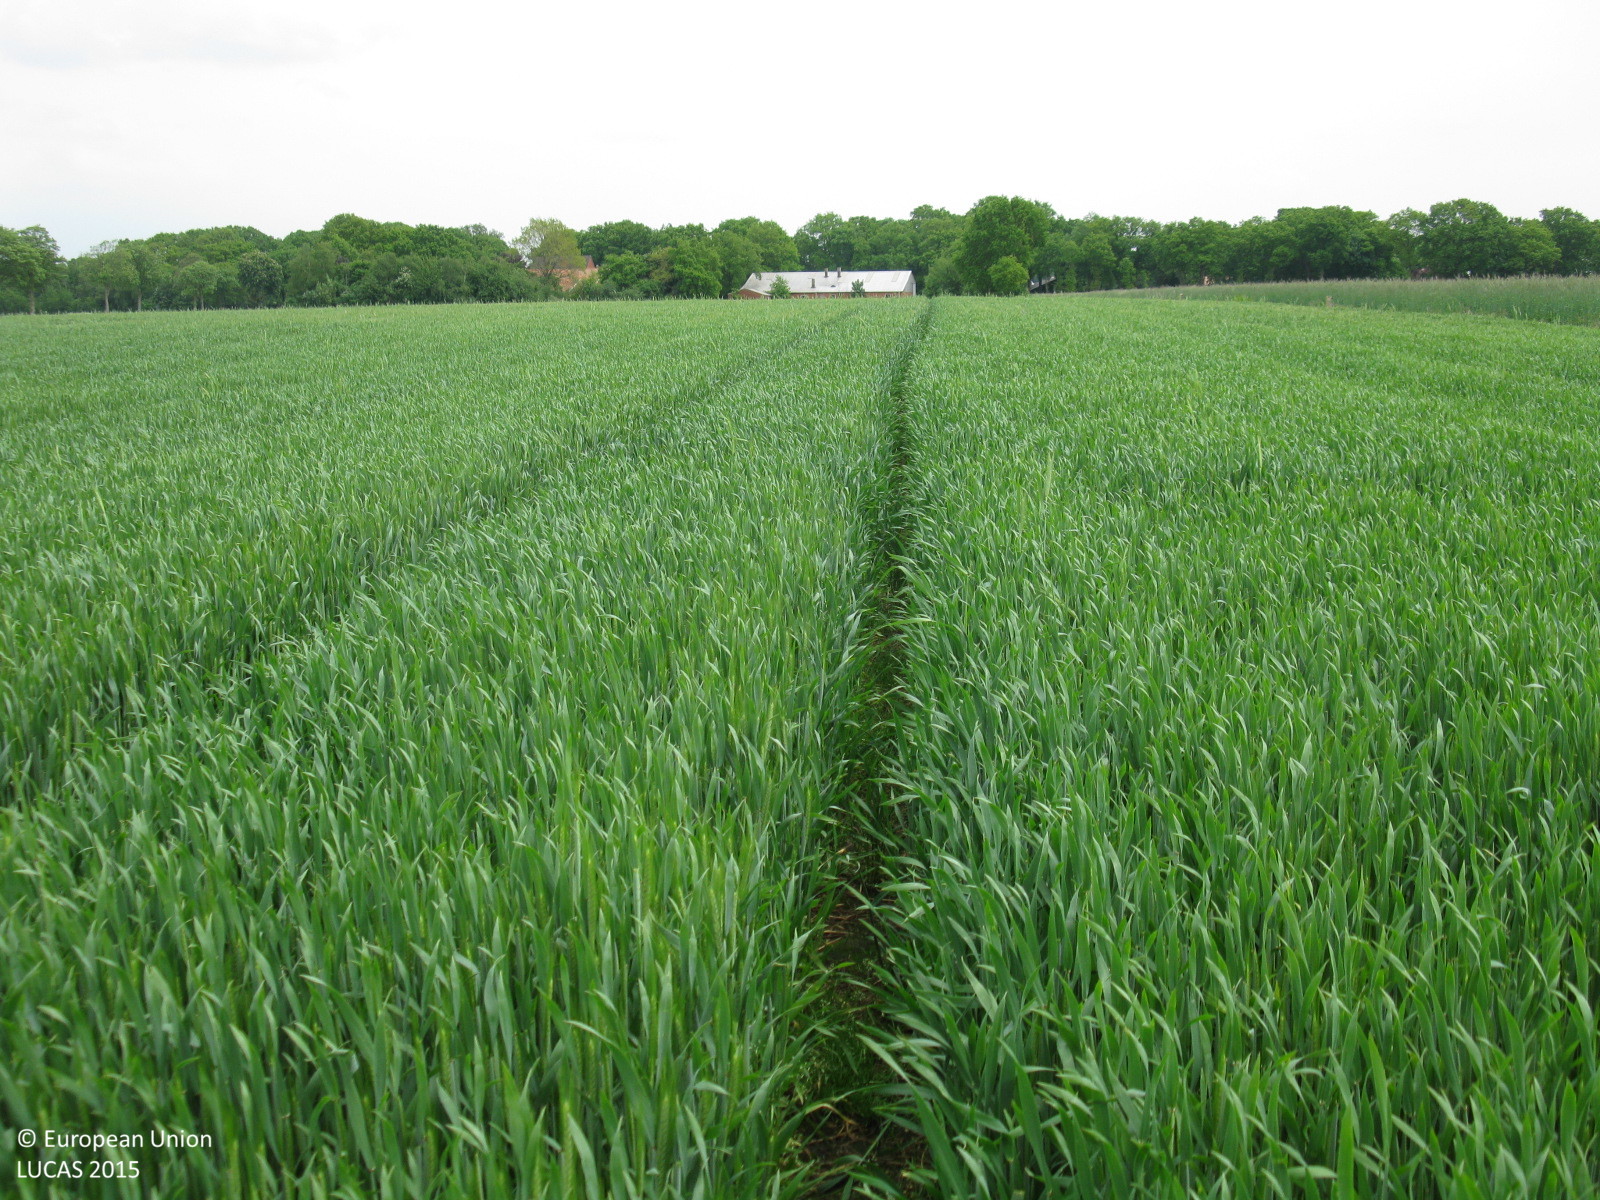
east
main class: Cropland
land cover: Triticale
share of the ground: > 75 %
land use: Agriculture (excluding fallow land and kitchen gardens)
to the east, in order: Triticale
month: May
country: DE
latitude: 52.9963
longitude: 7.3931
